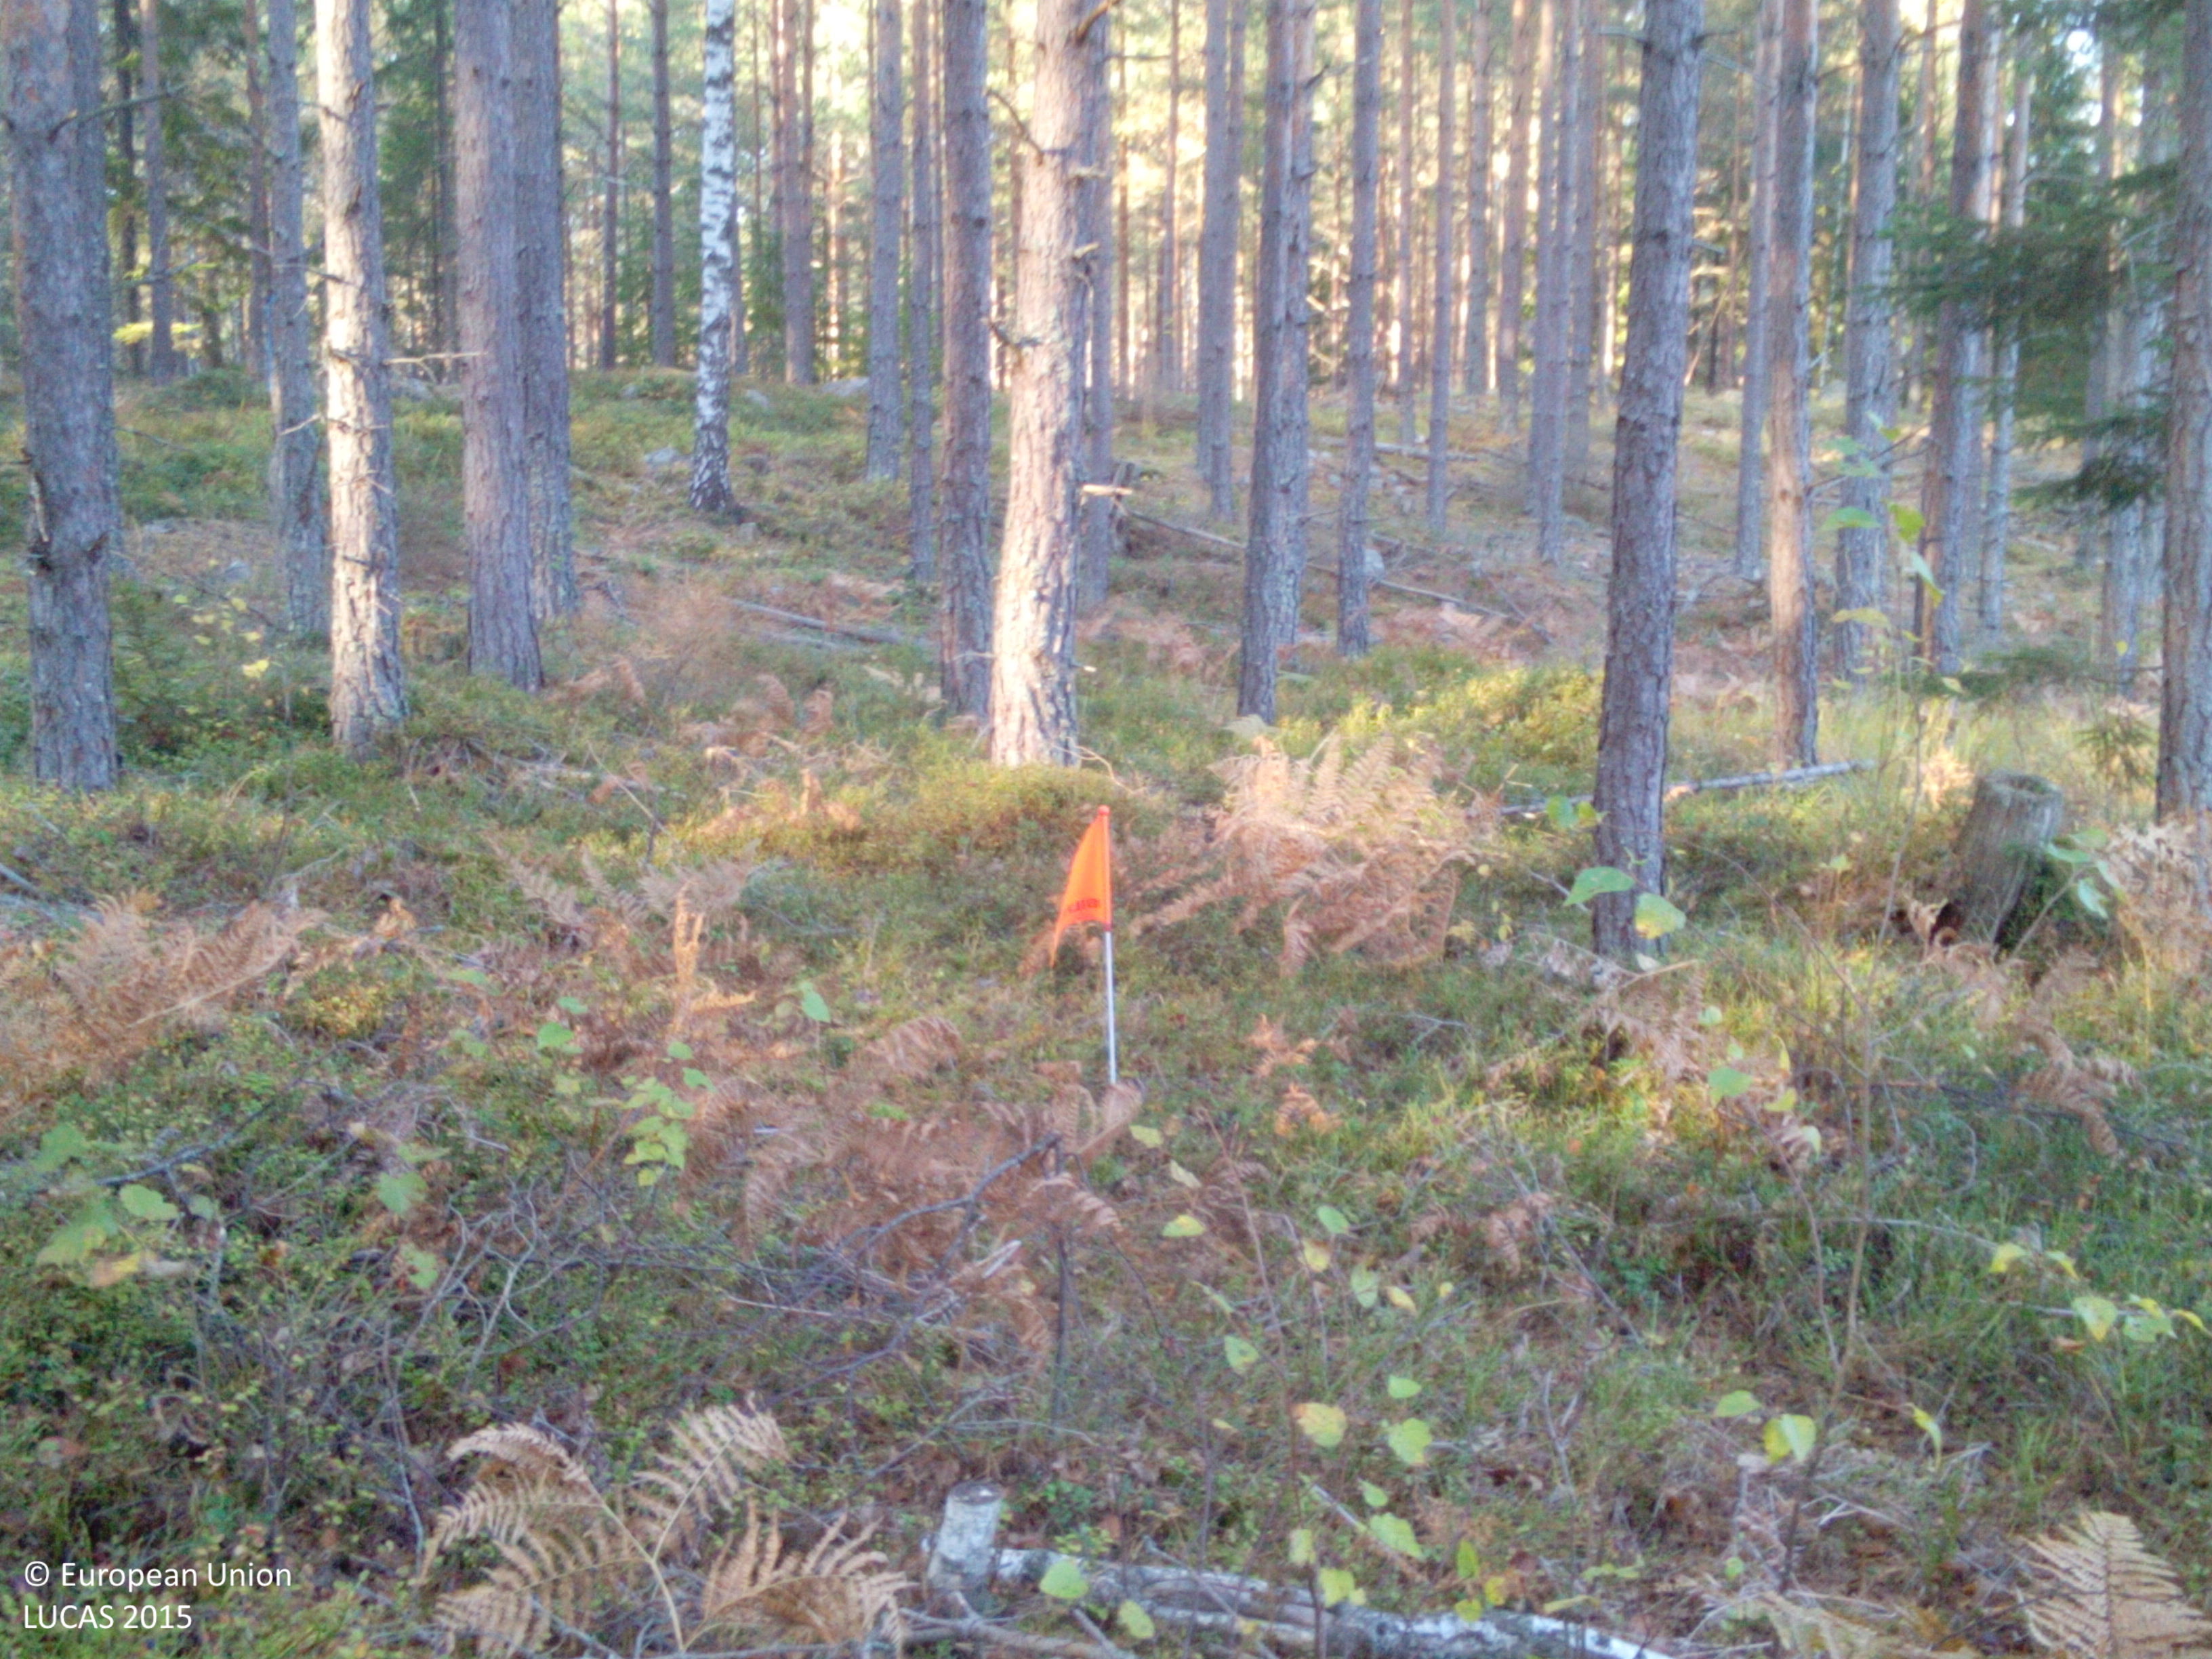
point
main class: Woodland
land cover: Pine dominated coniferous woodland
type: boreal forest
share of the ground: > 75 %
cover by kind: coniferous forest trees 85 %, herbaceous plants 10 %, lichens and mosses 5 %
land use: Forestry
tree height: > 5 m
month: October
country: SE
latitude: 58.8650
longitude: 16.3234
